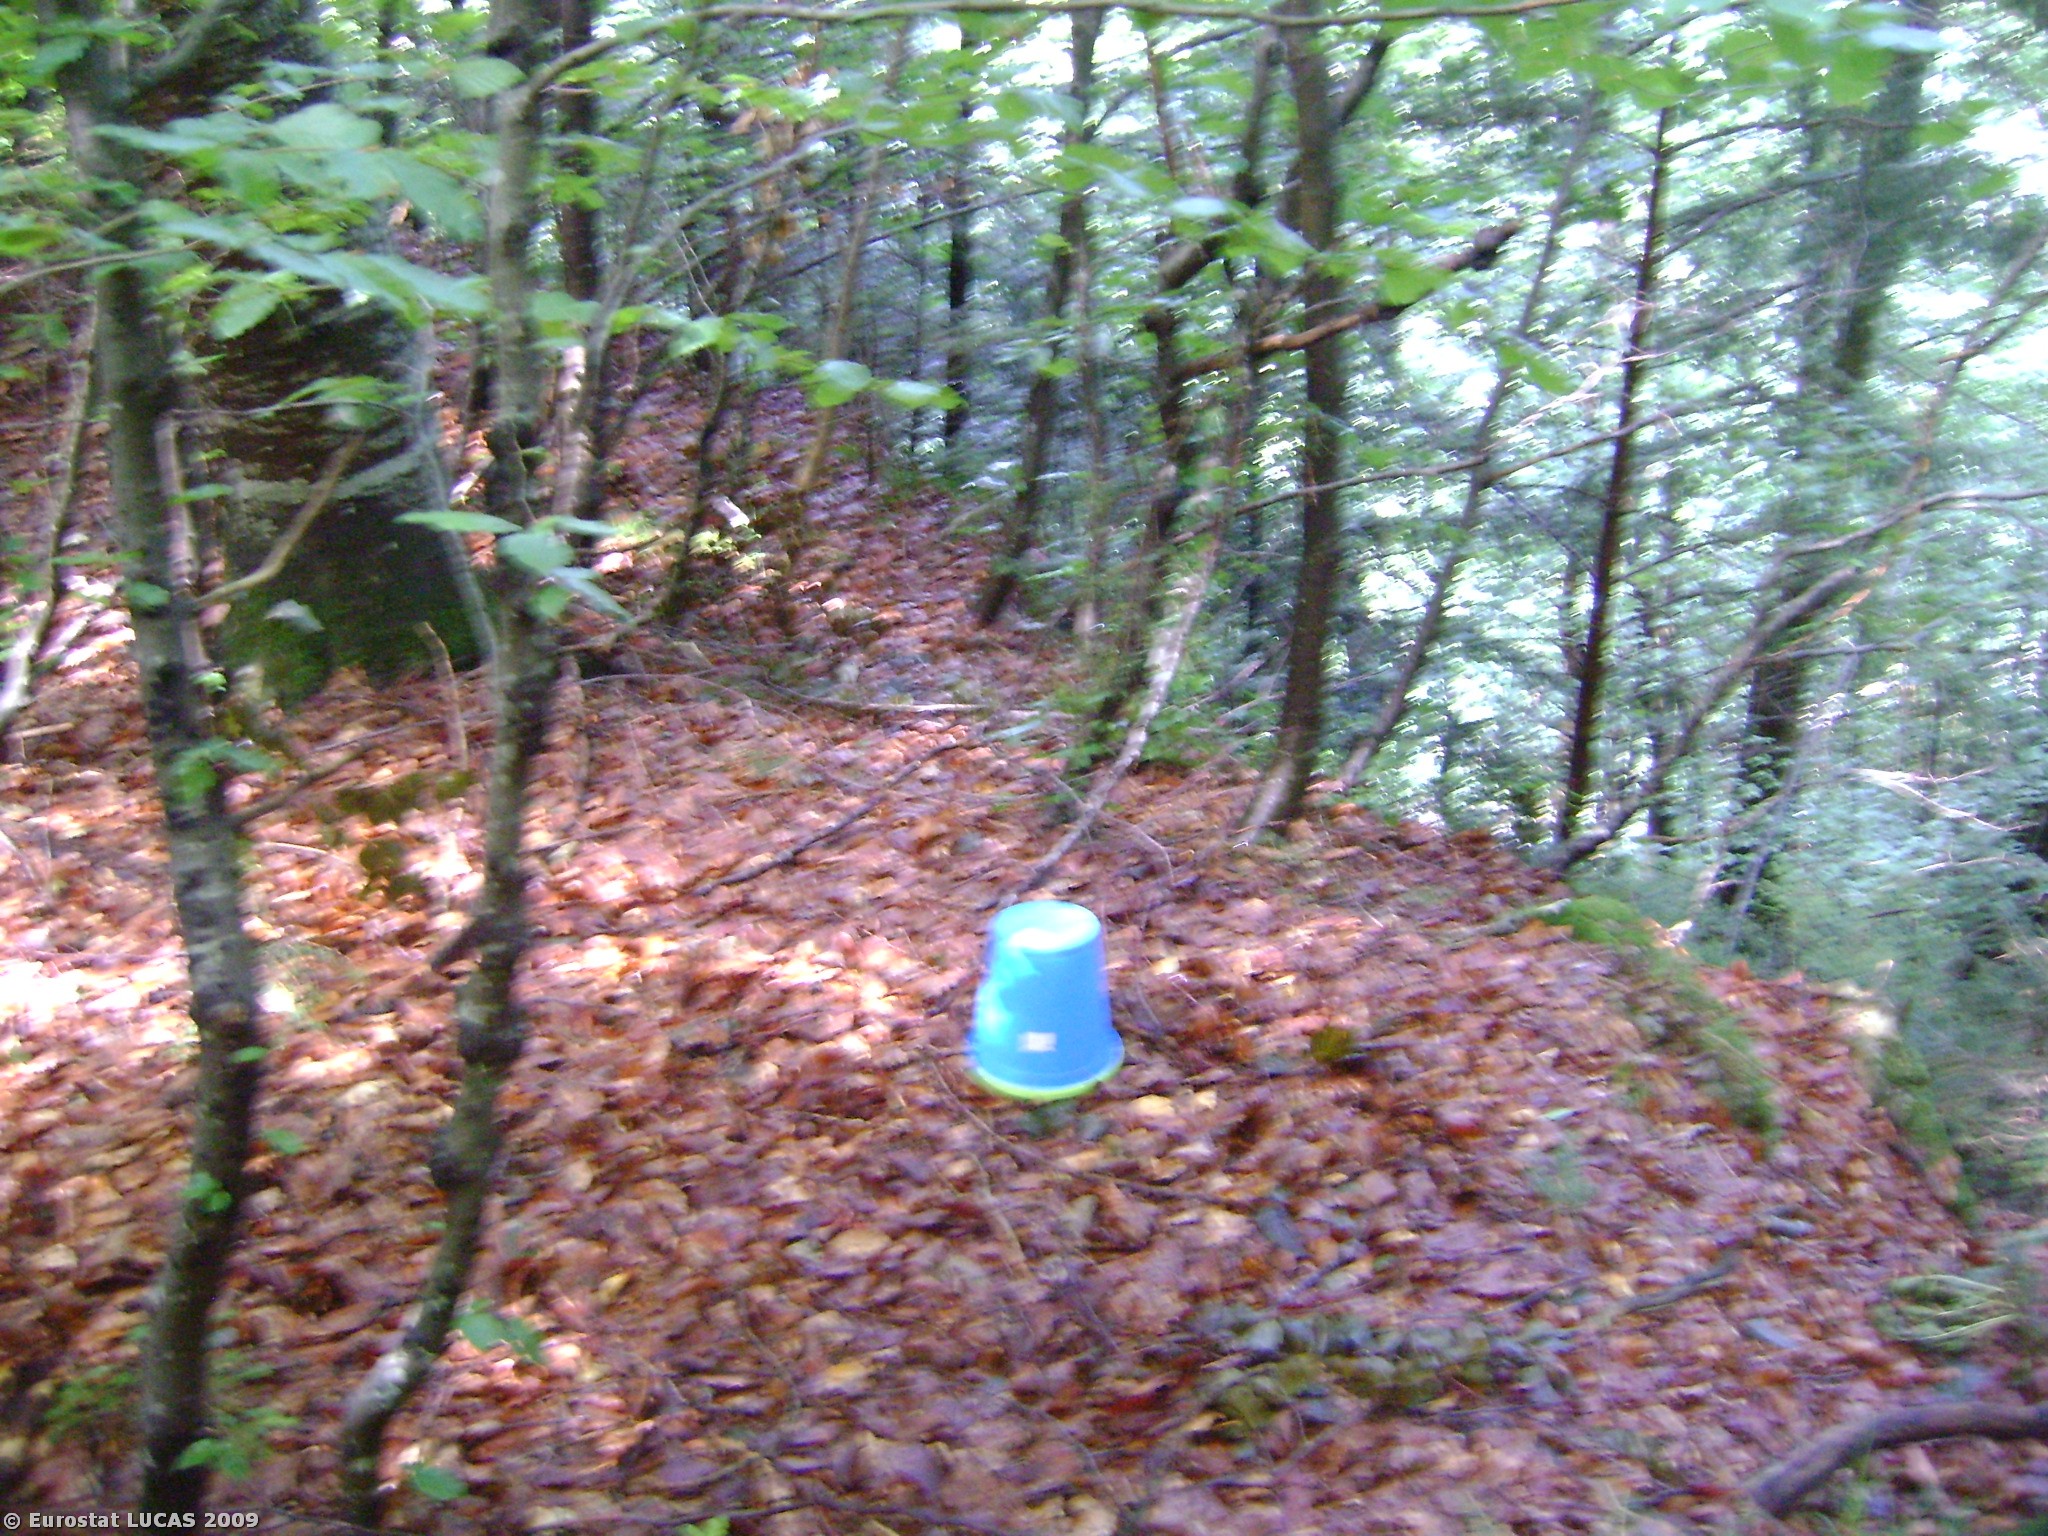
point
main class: Woodland
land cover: Broadleaved woodland
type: beech forest
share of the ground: > 75 %
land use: Forestry
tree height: > 5 m
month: August
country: AT
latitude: 47.3051
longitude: 9.6697
